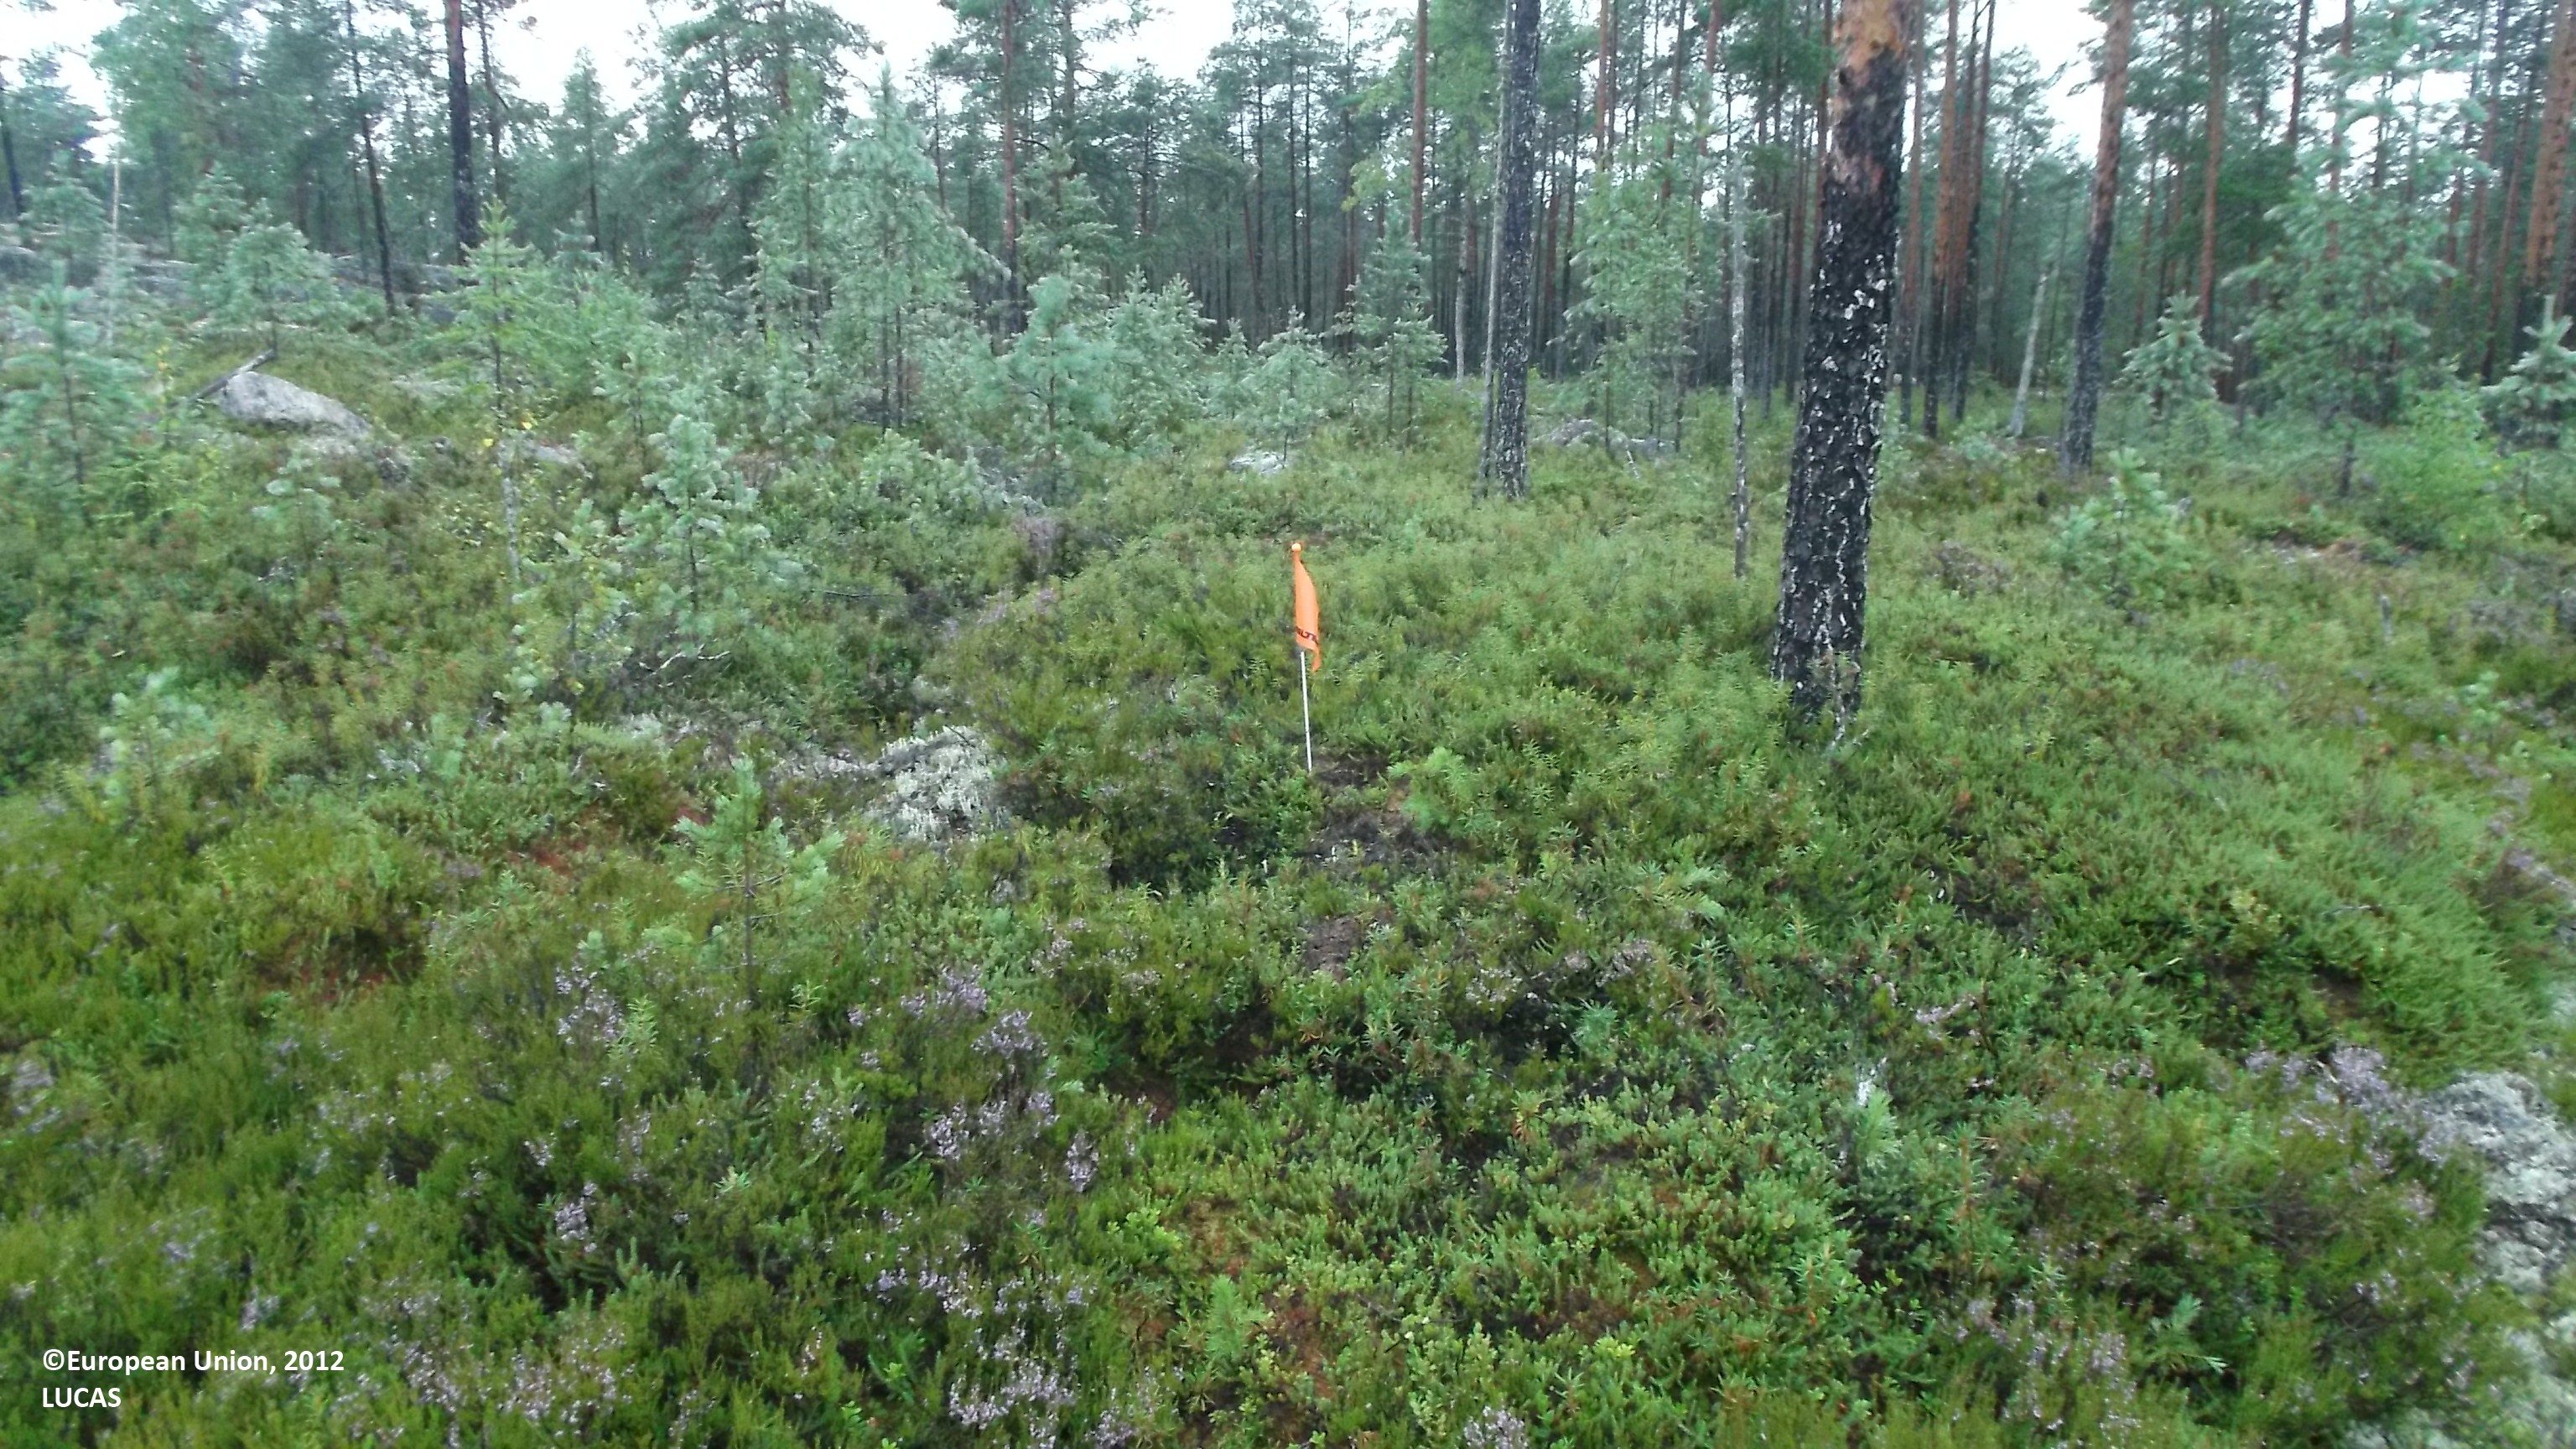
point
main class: Woodland
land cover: Pine dominated coniferous woodland
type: boreal forest
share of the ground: 10 - 25 %
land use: Forestry
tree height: < 5 m
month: August
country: FI
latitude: 63.2343
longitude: 23.8636
